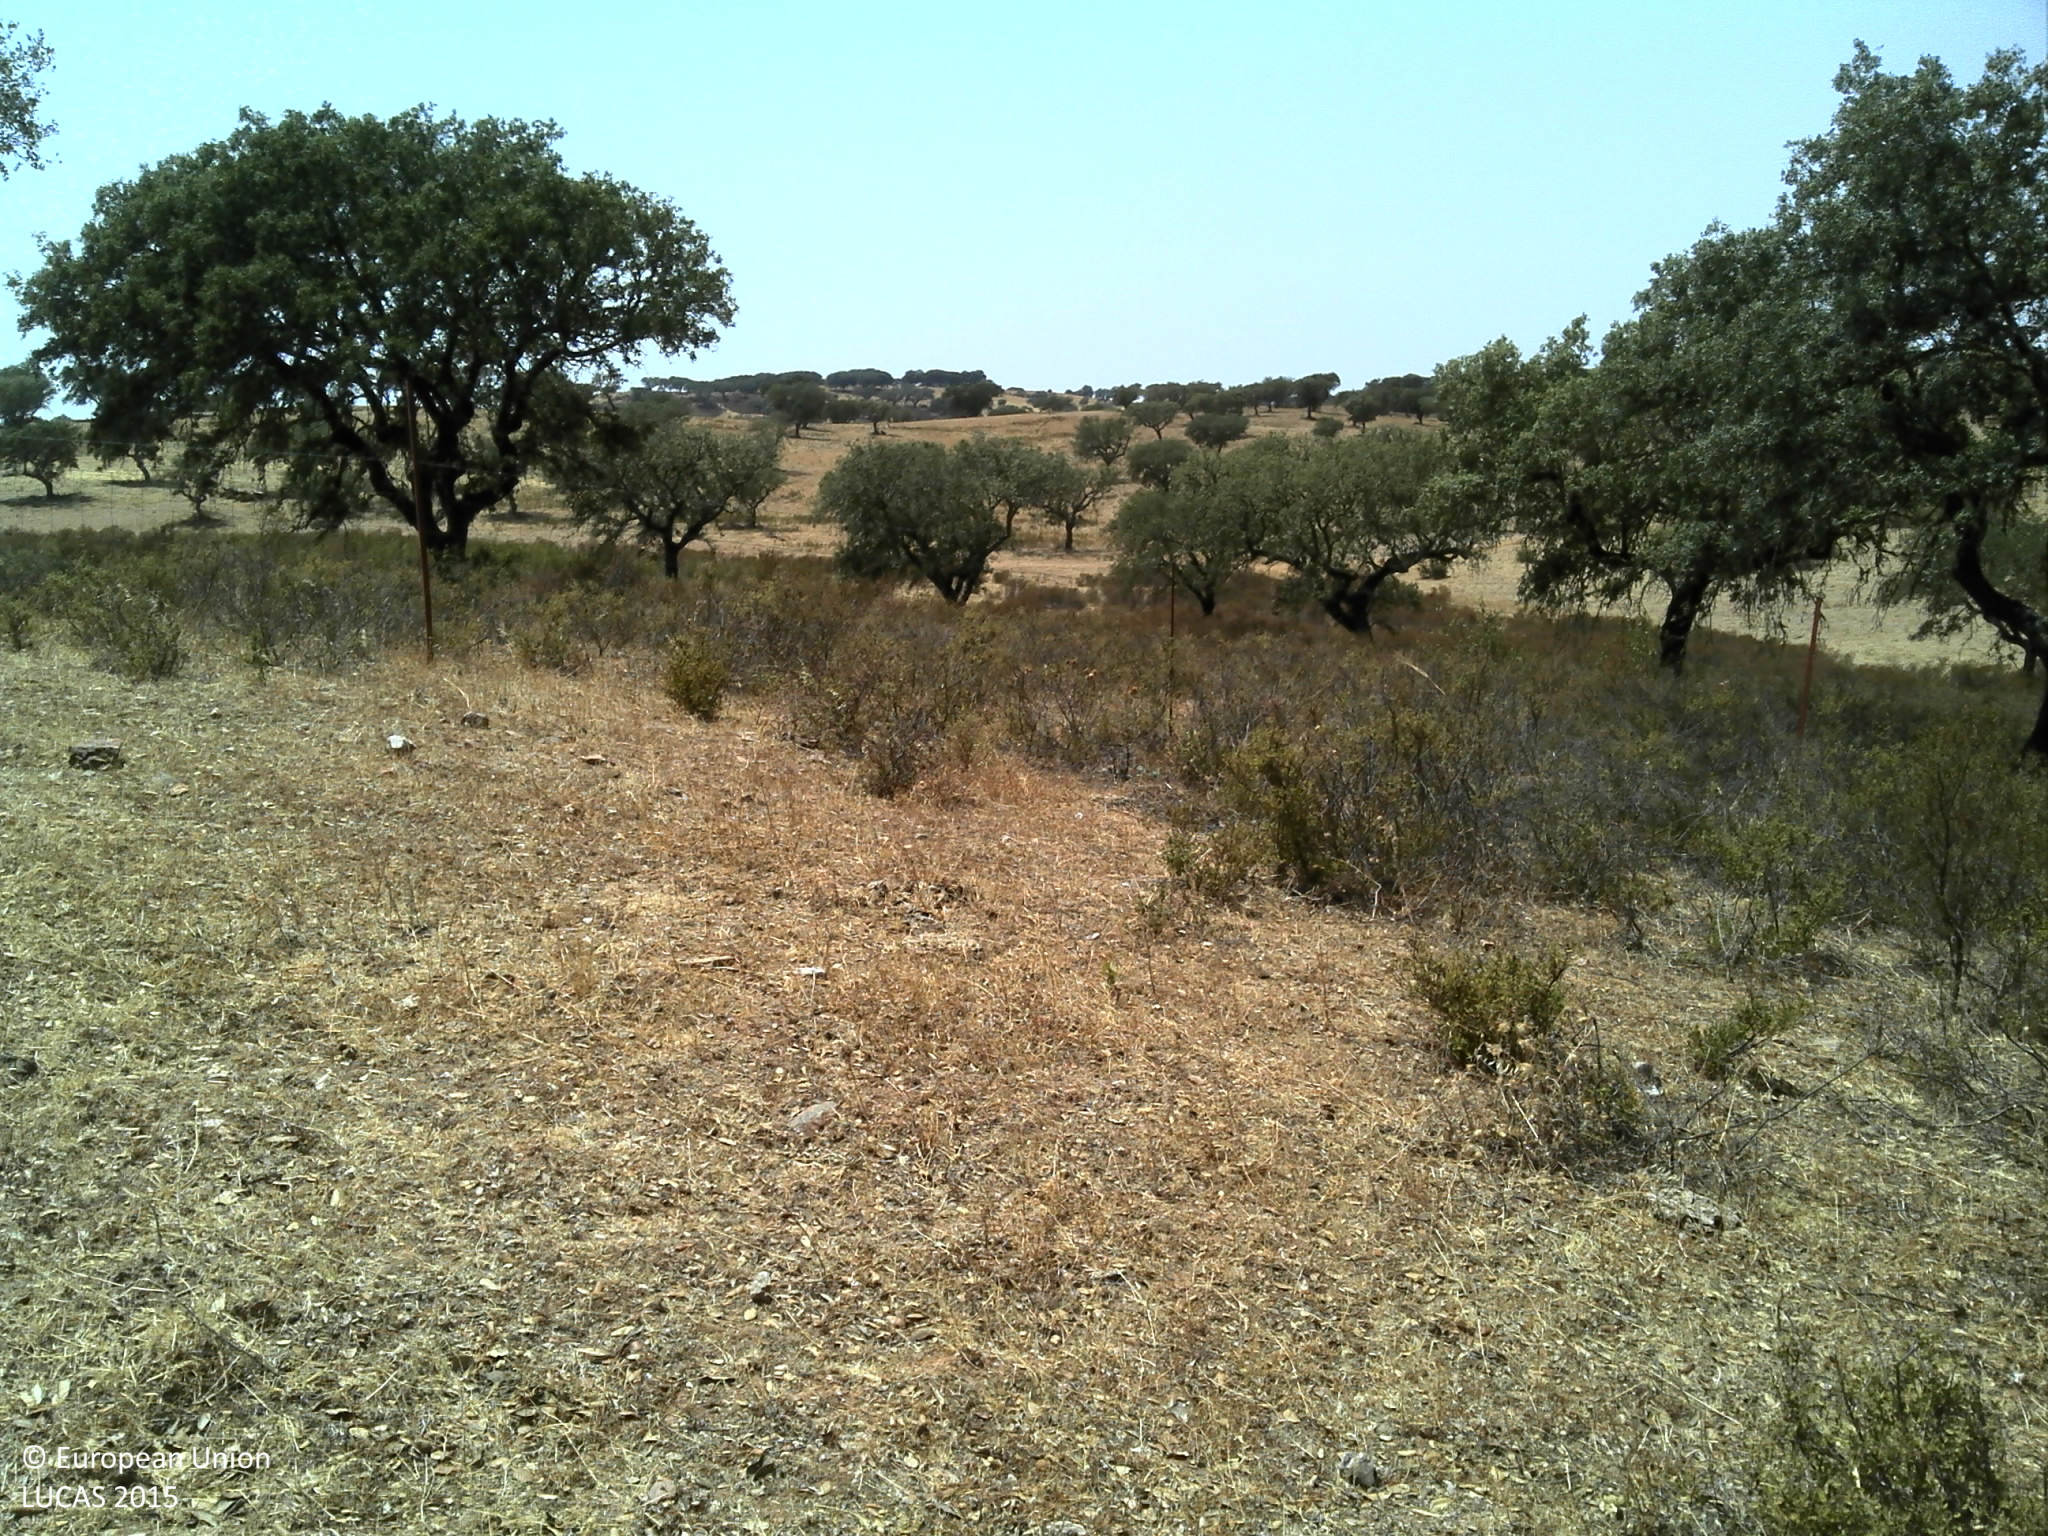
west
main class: Woodland
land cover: Broadleaved woodland
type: broadleaved evergreen forest
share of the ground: 25 - 50 %
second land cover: Grassland without tree/shrub cover
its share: 10 - 25 %
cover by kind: broadleaved forest trees 35 %, unconsolidated bare surface 35 %, herbaceous plants 20 %, shrubs 5 %
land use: Forestry
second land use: Agriculture (excluding fallow land and kitchen gardens)
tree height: > 5 m
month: July
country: PT
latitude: 37.7588
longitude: -7.7848
